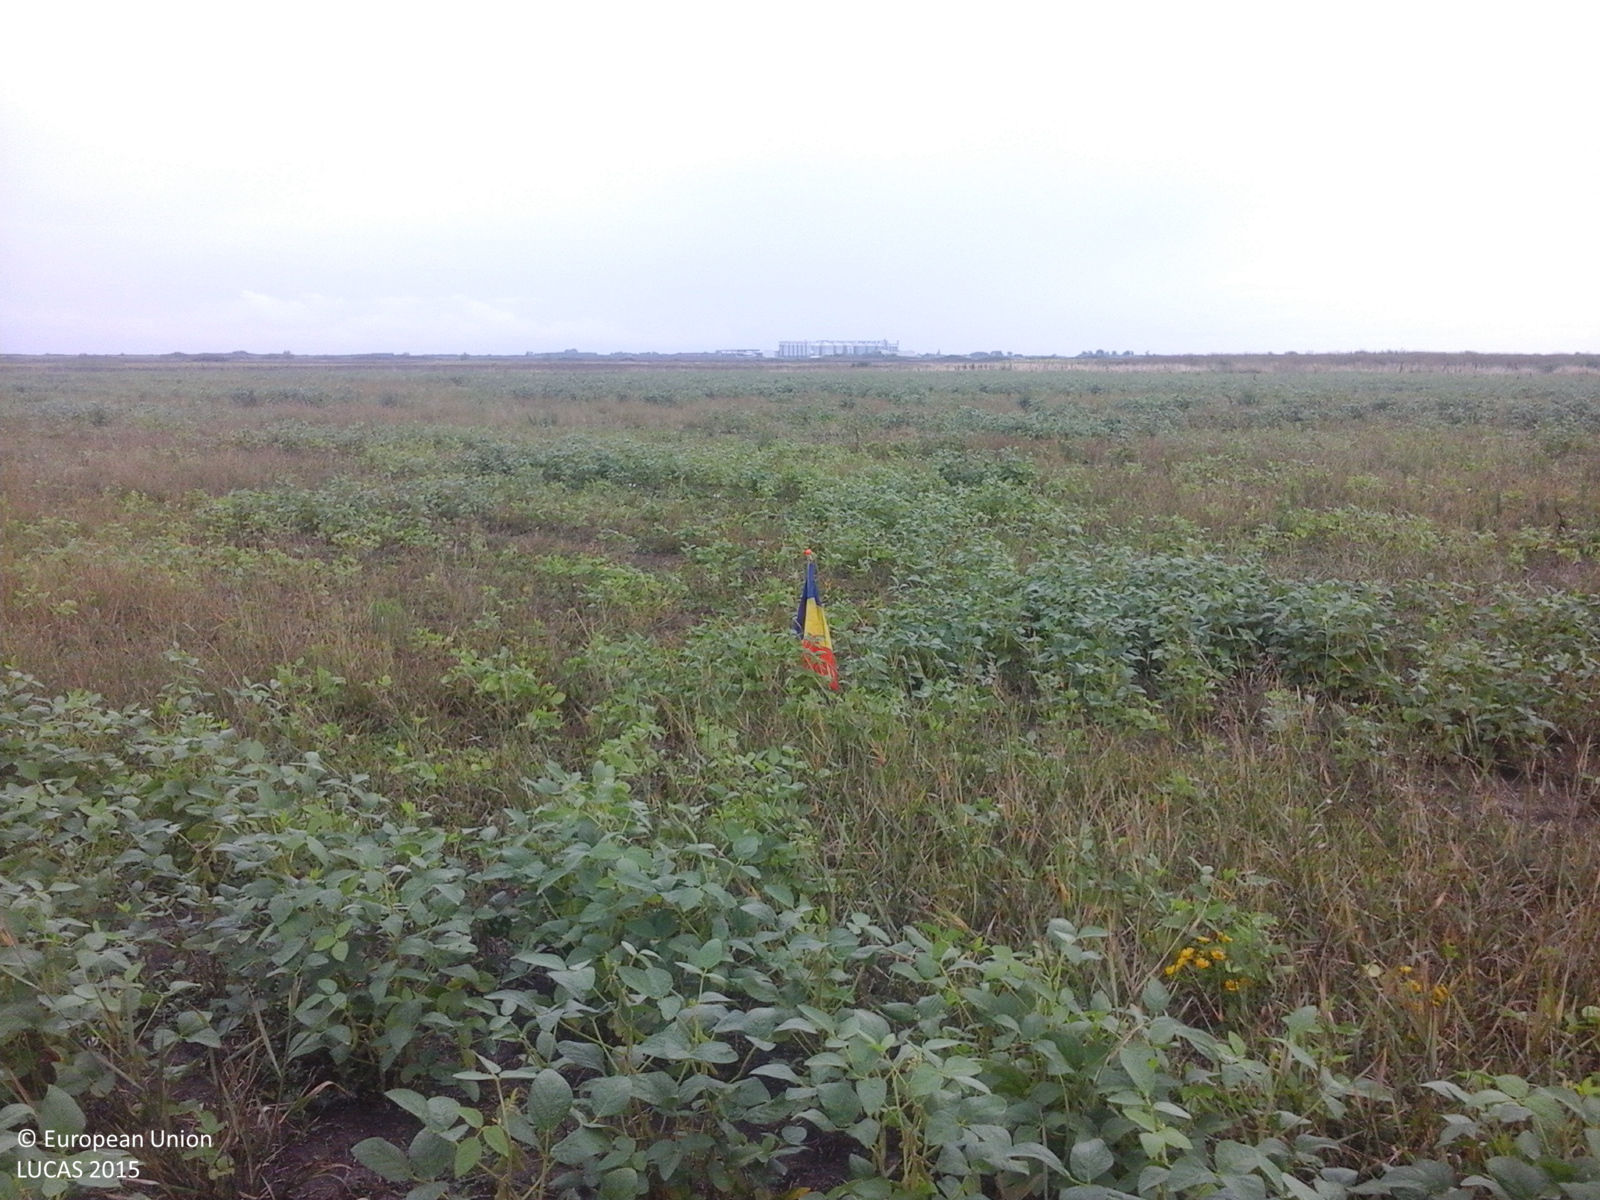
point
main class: Cropland
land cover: Soya
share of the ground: > 75 %
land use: Agriculture (excluding fallow land and kitchen gardens)
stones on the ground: < 10 %
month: August
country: RO
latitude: 45.3853
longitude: 20.9710
